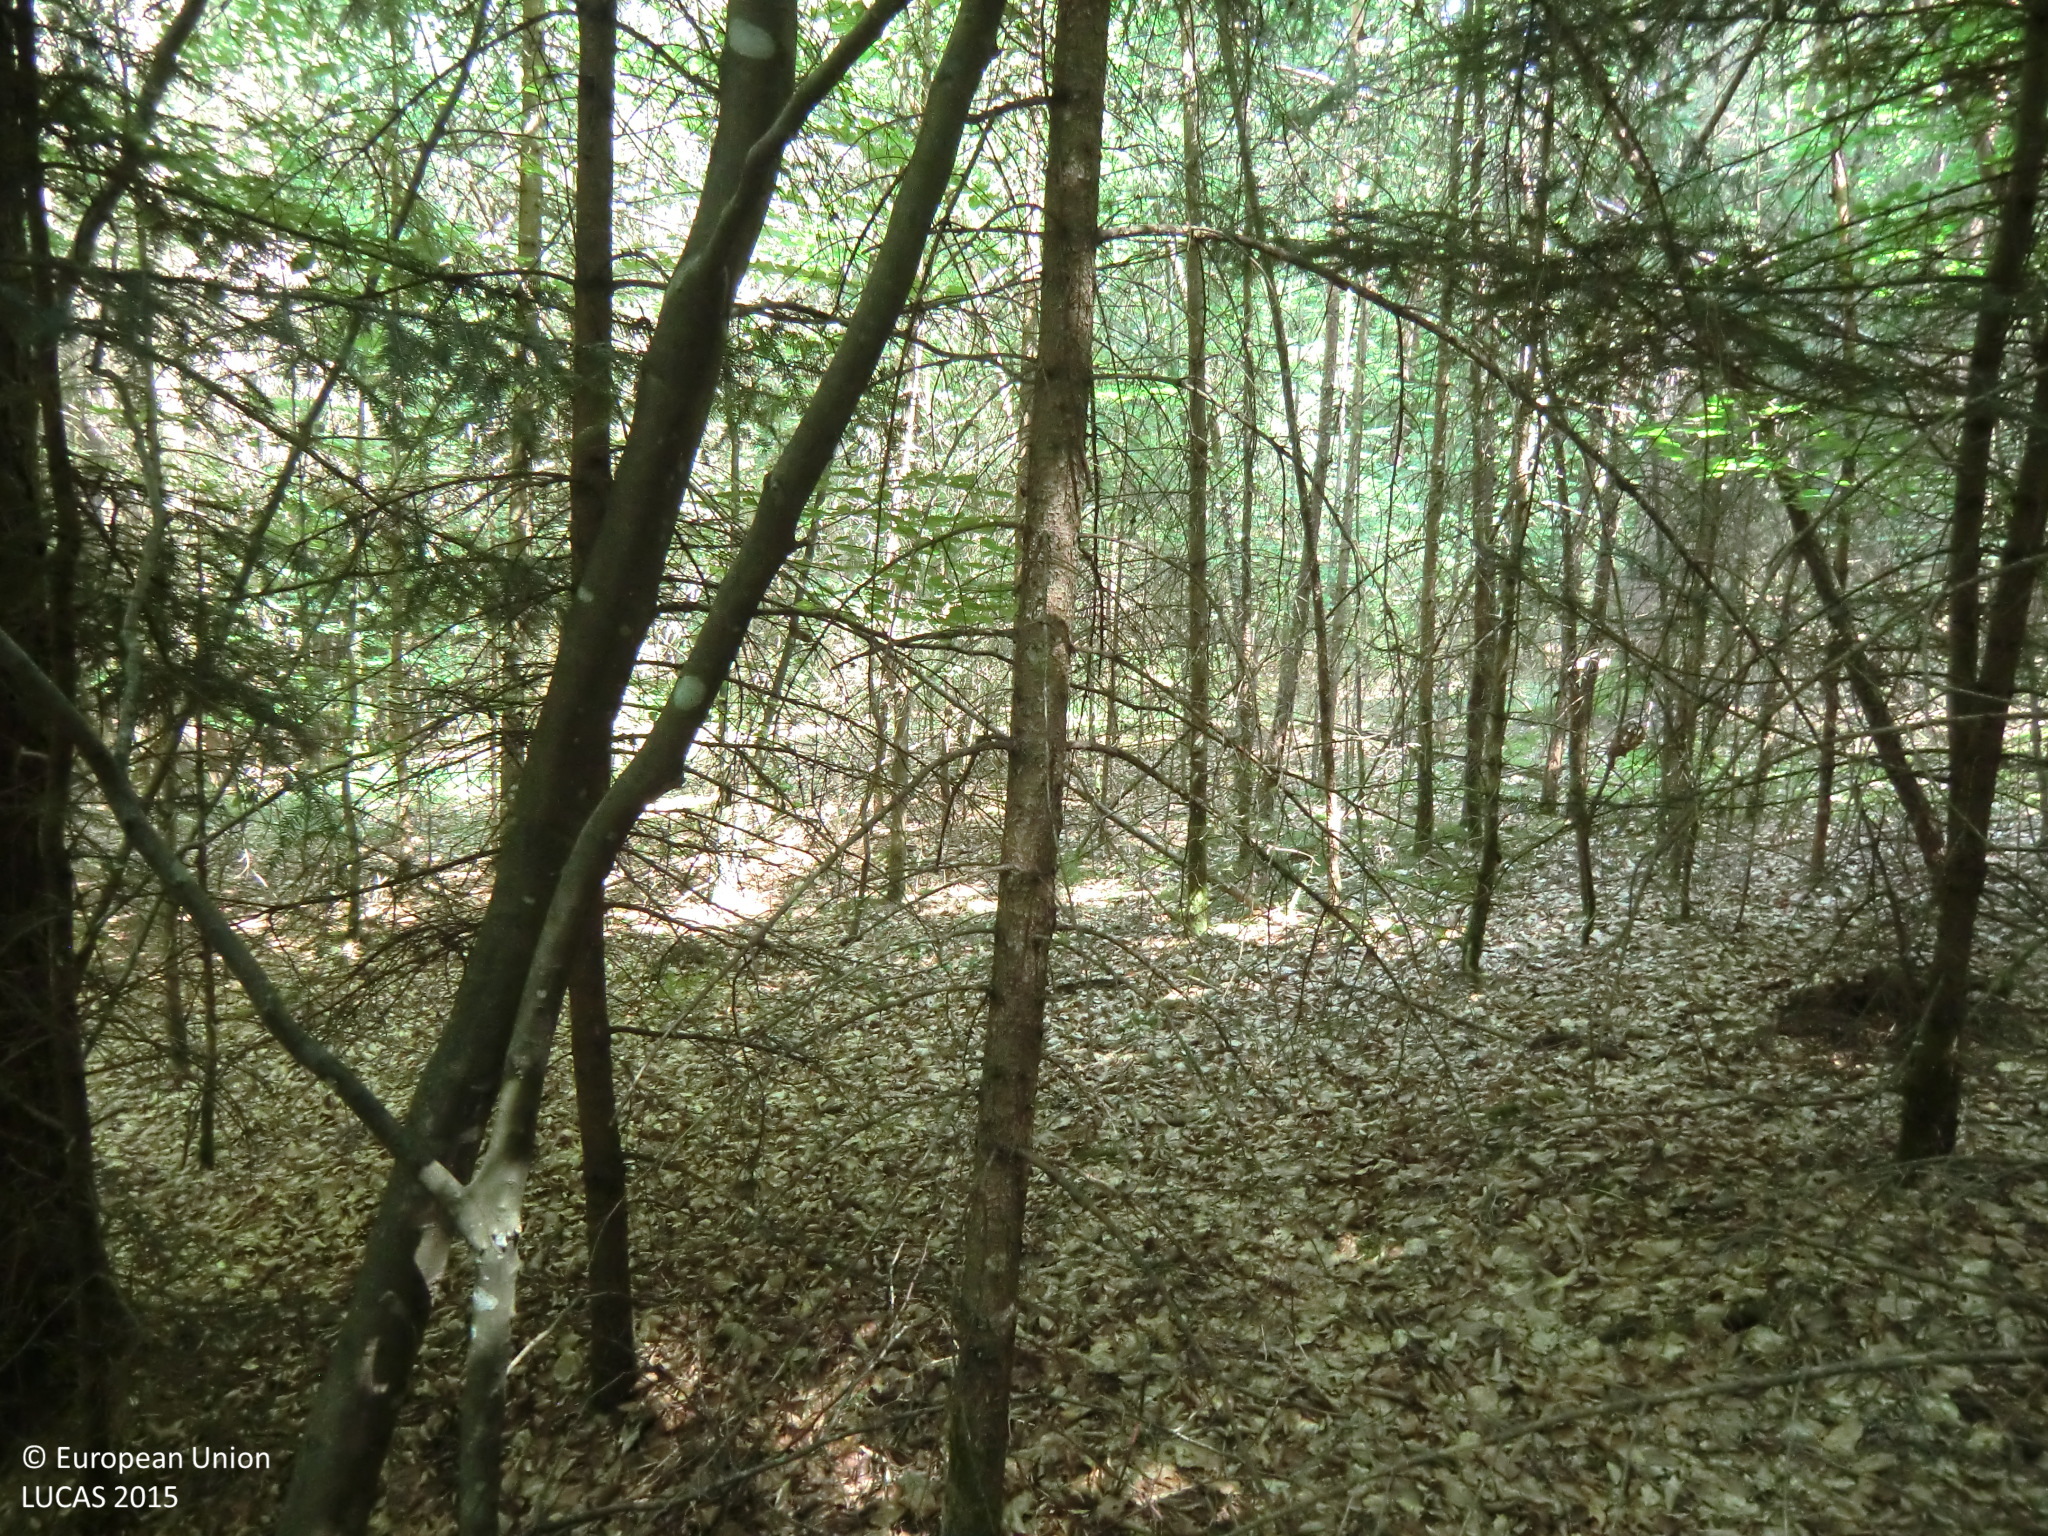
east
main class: Woodland
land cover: Spruce dominated mixed woodland
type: hemiboreal forest and nemoral coniferous forest and mixed broadleaved-coniferous forest
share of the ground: > 75 %
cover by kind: coniferous forest trees 60 %, broadleaved forest trees 35 %, unconsolidated bare surface 5 %
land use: Forestry
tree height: > 5 m
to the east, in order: Spruce dominated mixed woodland; Tracks; Spruce dominated mixed woodland; Broadleaved woodland; Grass margins; Tracks; Grass margins; Maize
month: June
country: AT
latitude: 47.1898
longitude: 15.7419
